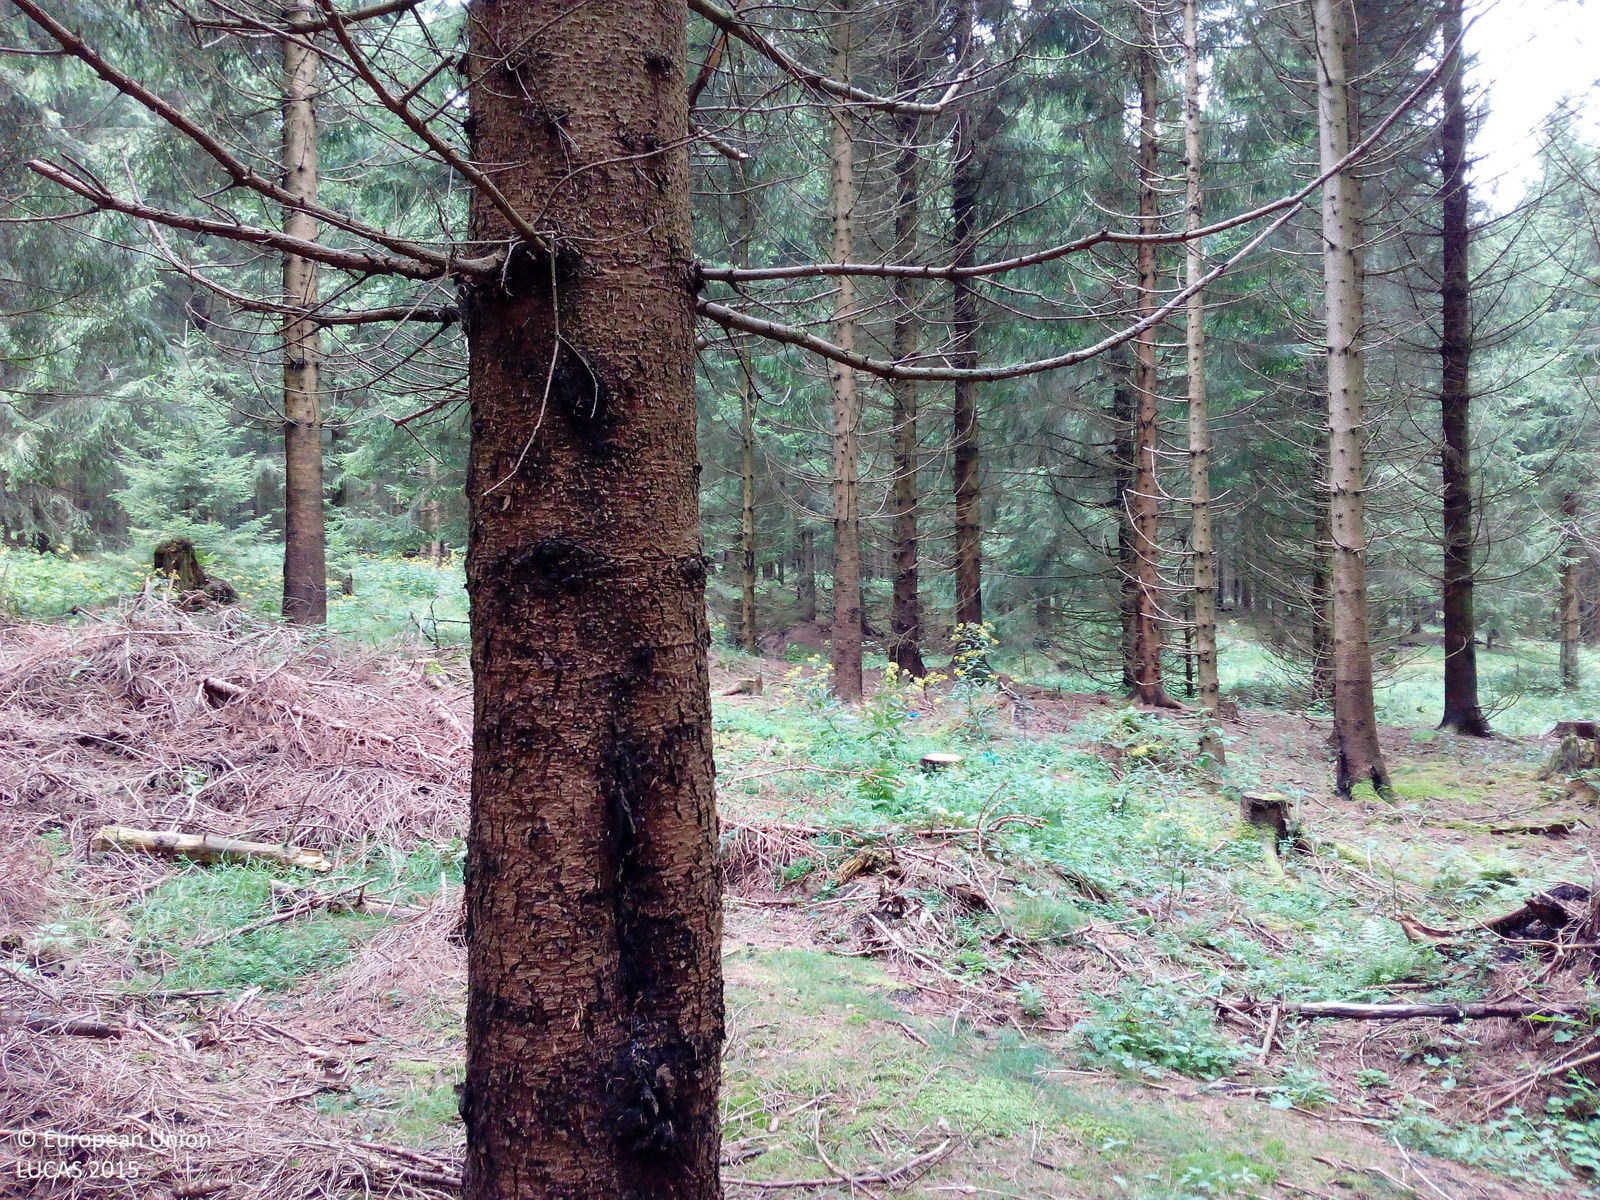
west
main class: Woodland
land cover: Spruce dominated coniferous woodland
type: hemiboreal forest and nemoral coniferous forest and mixed broadleaved-coniferous forest
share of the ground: > 75 %
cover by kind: coniferous forest trees 100 %
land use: Forestry
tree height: > 5 m
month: August
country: DE
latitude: 51.7840
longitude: 10.2753
